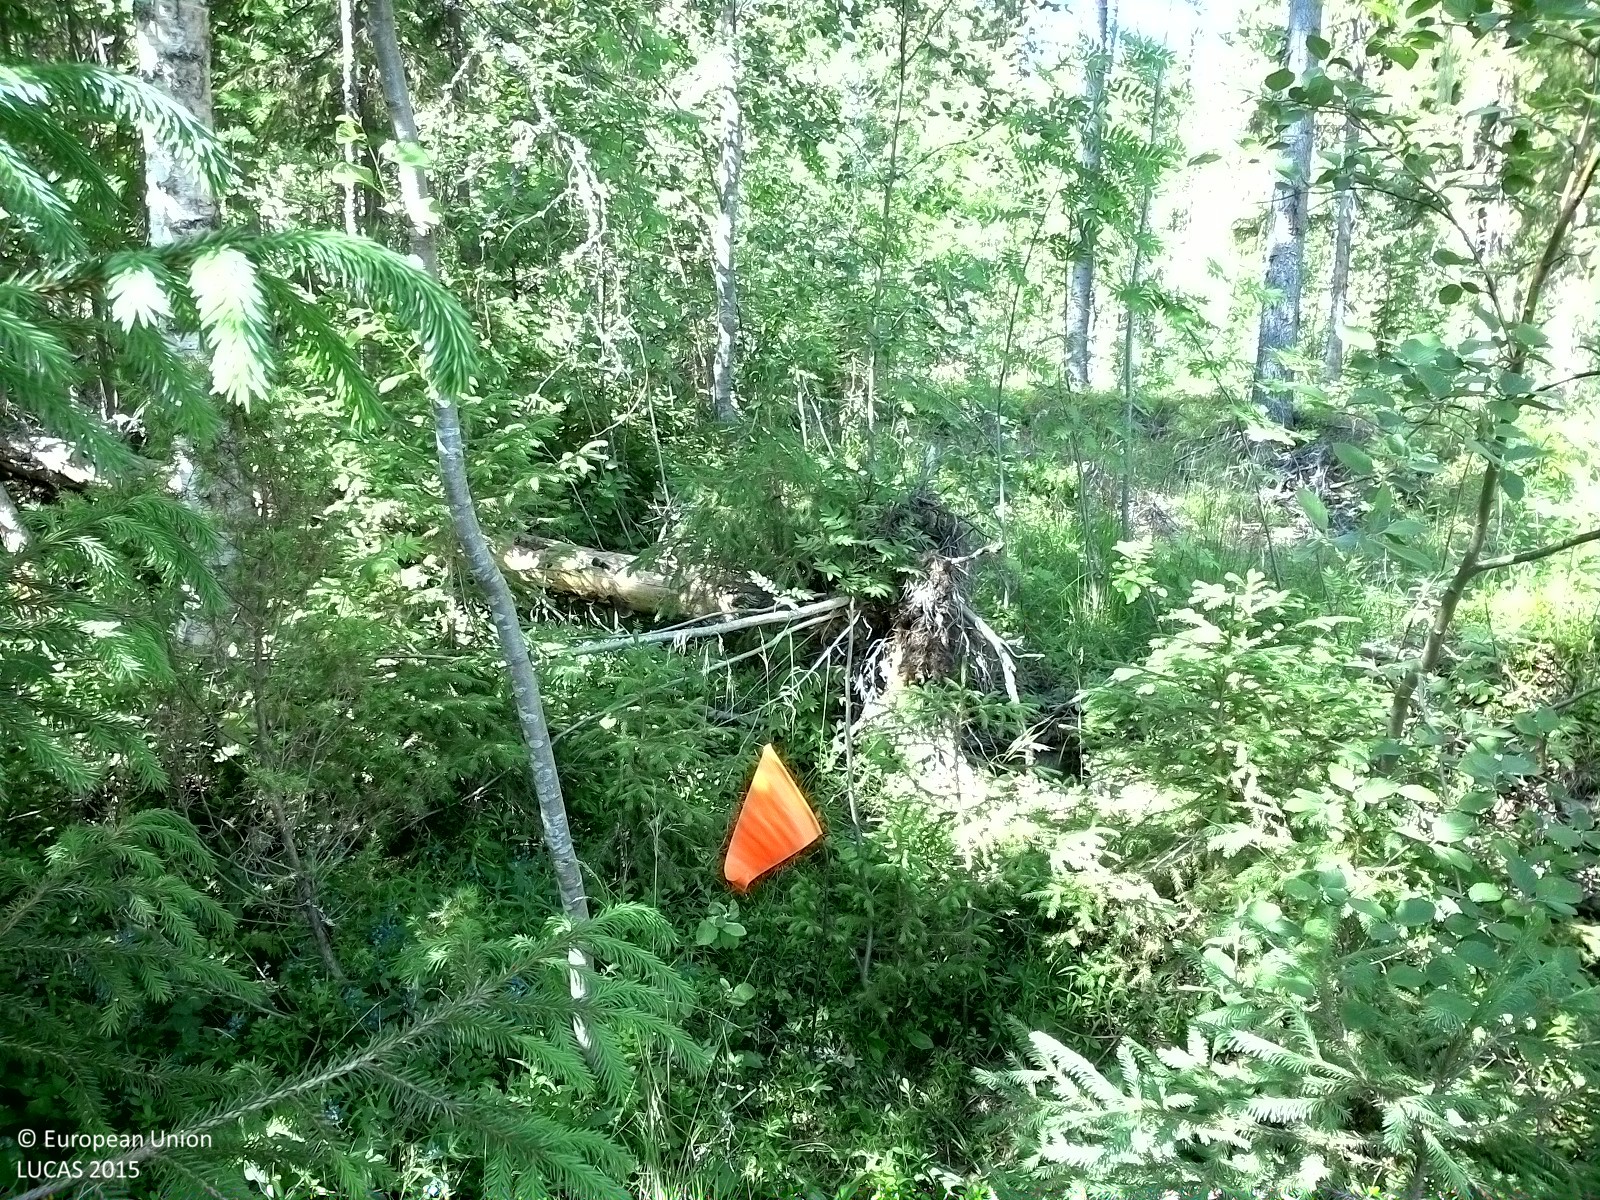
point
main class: Woodland
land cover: Spruce dominated mixed woodland
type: boreal forest
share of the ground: > 75 %
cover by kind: broadleaved forest trees 50 %, coniferous forest trees 35 %, herbaceous plants 15 %
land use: Forestry
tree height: > 5 m
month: July
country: SE
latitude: 62.2697
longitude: 16.9736
